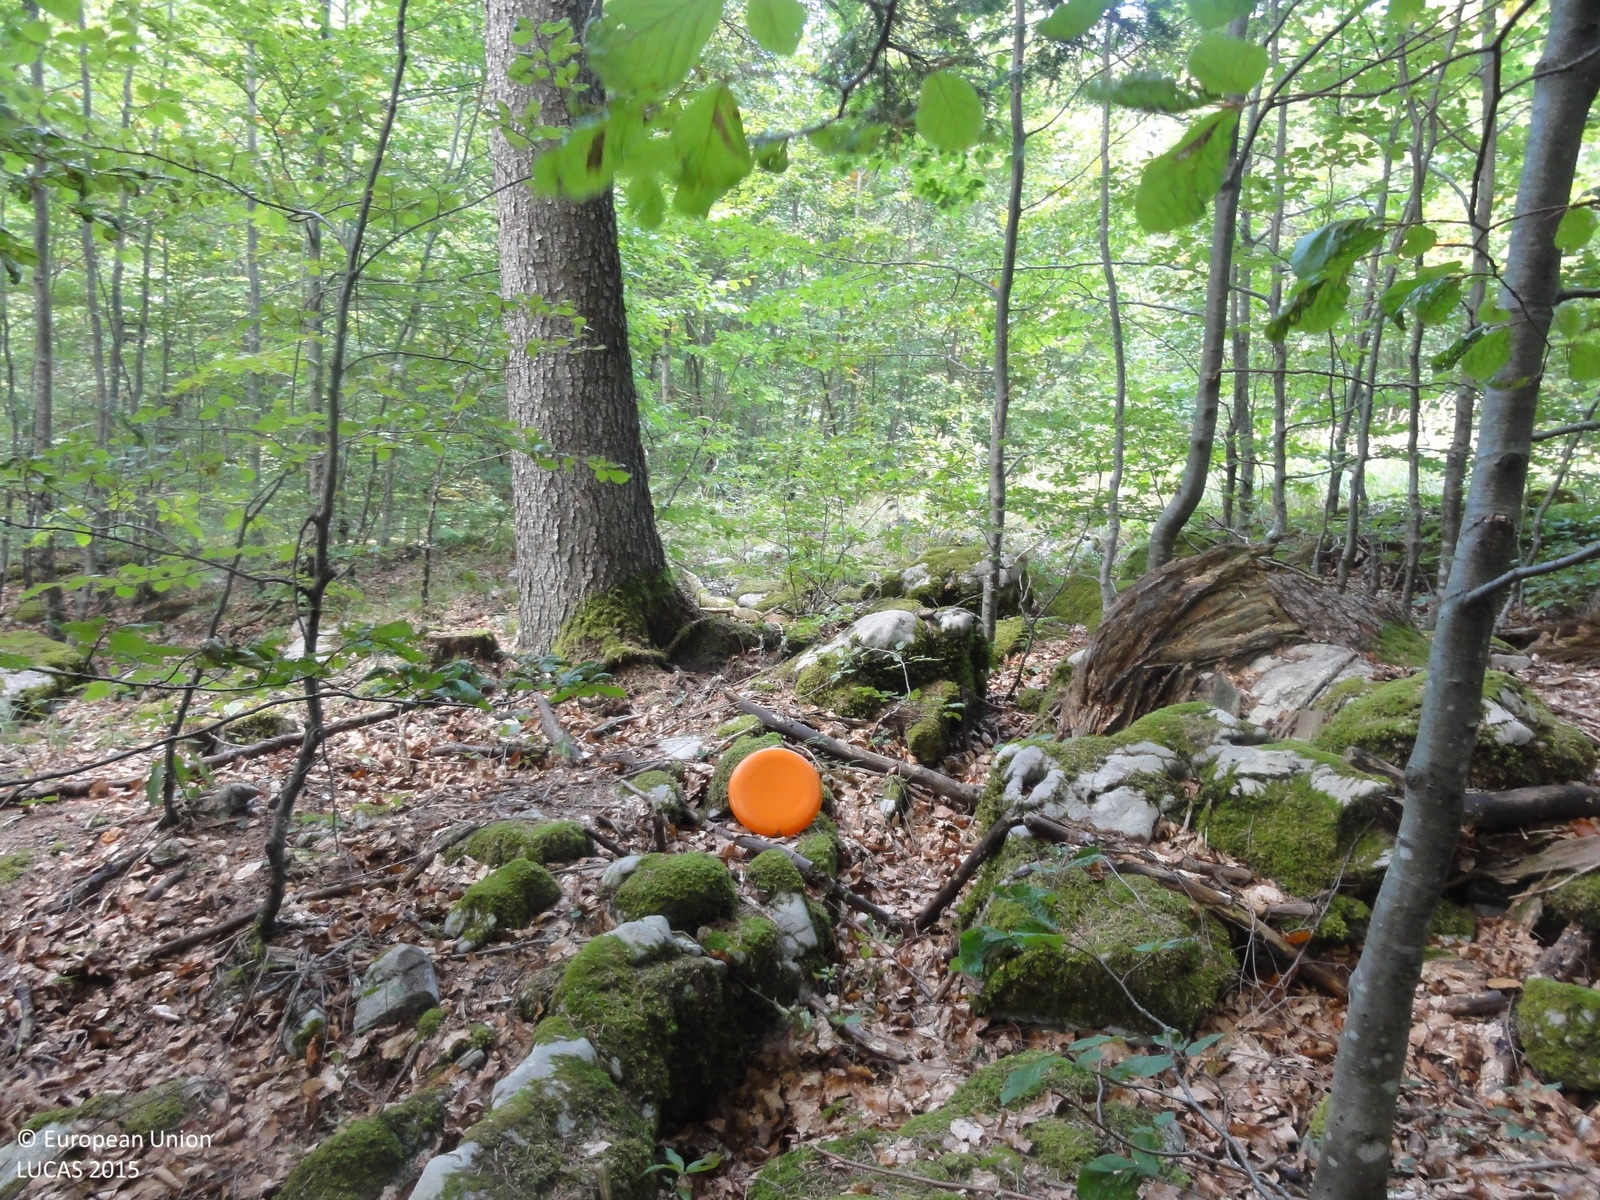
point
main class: Woodland
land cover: Spruce dominated mixed woodland
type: mountainous beech forest
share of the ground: > 75 %
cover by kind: broadleaved forest trees 55 %, coniferous forest trees 30 %, herbaceous plants 10 %, consolidated bare surface 5 %
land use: Forestry
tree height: > 5 m
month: September
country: SI
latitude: 45.6753
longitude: 14.9899
